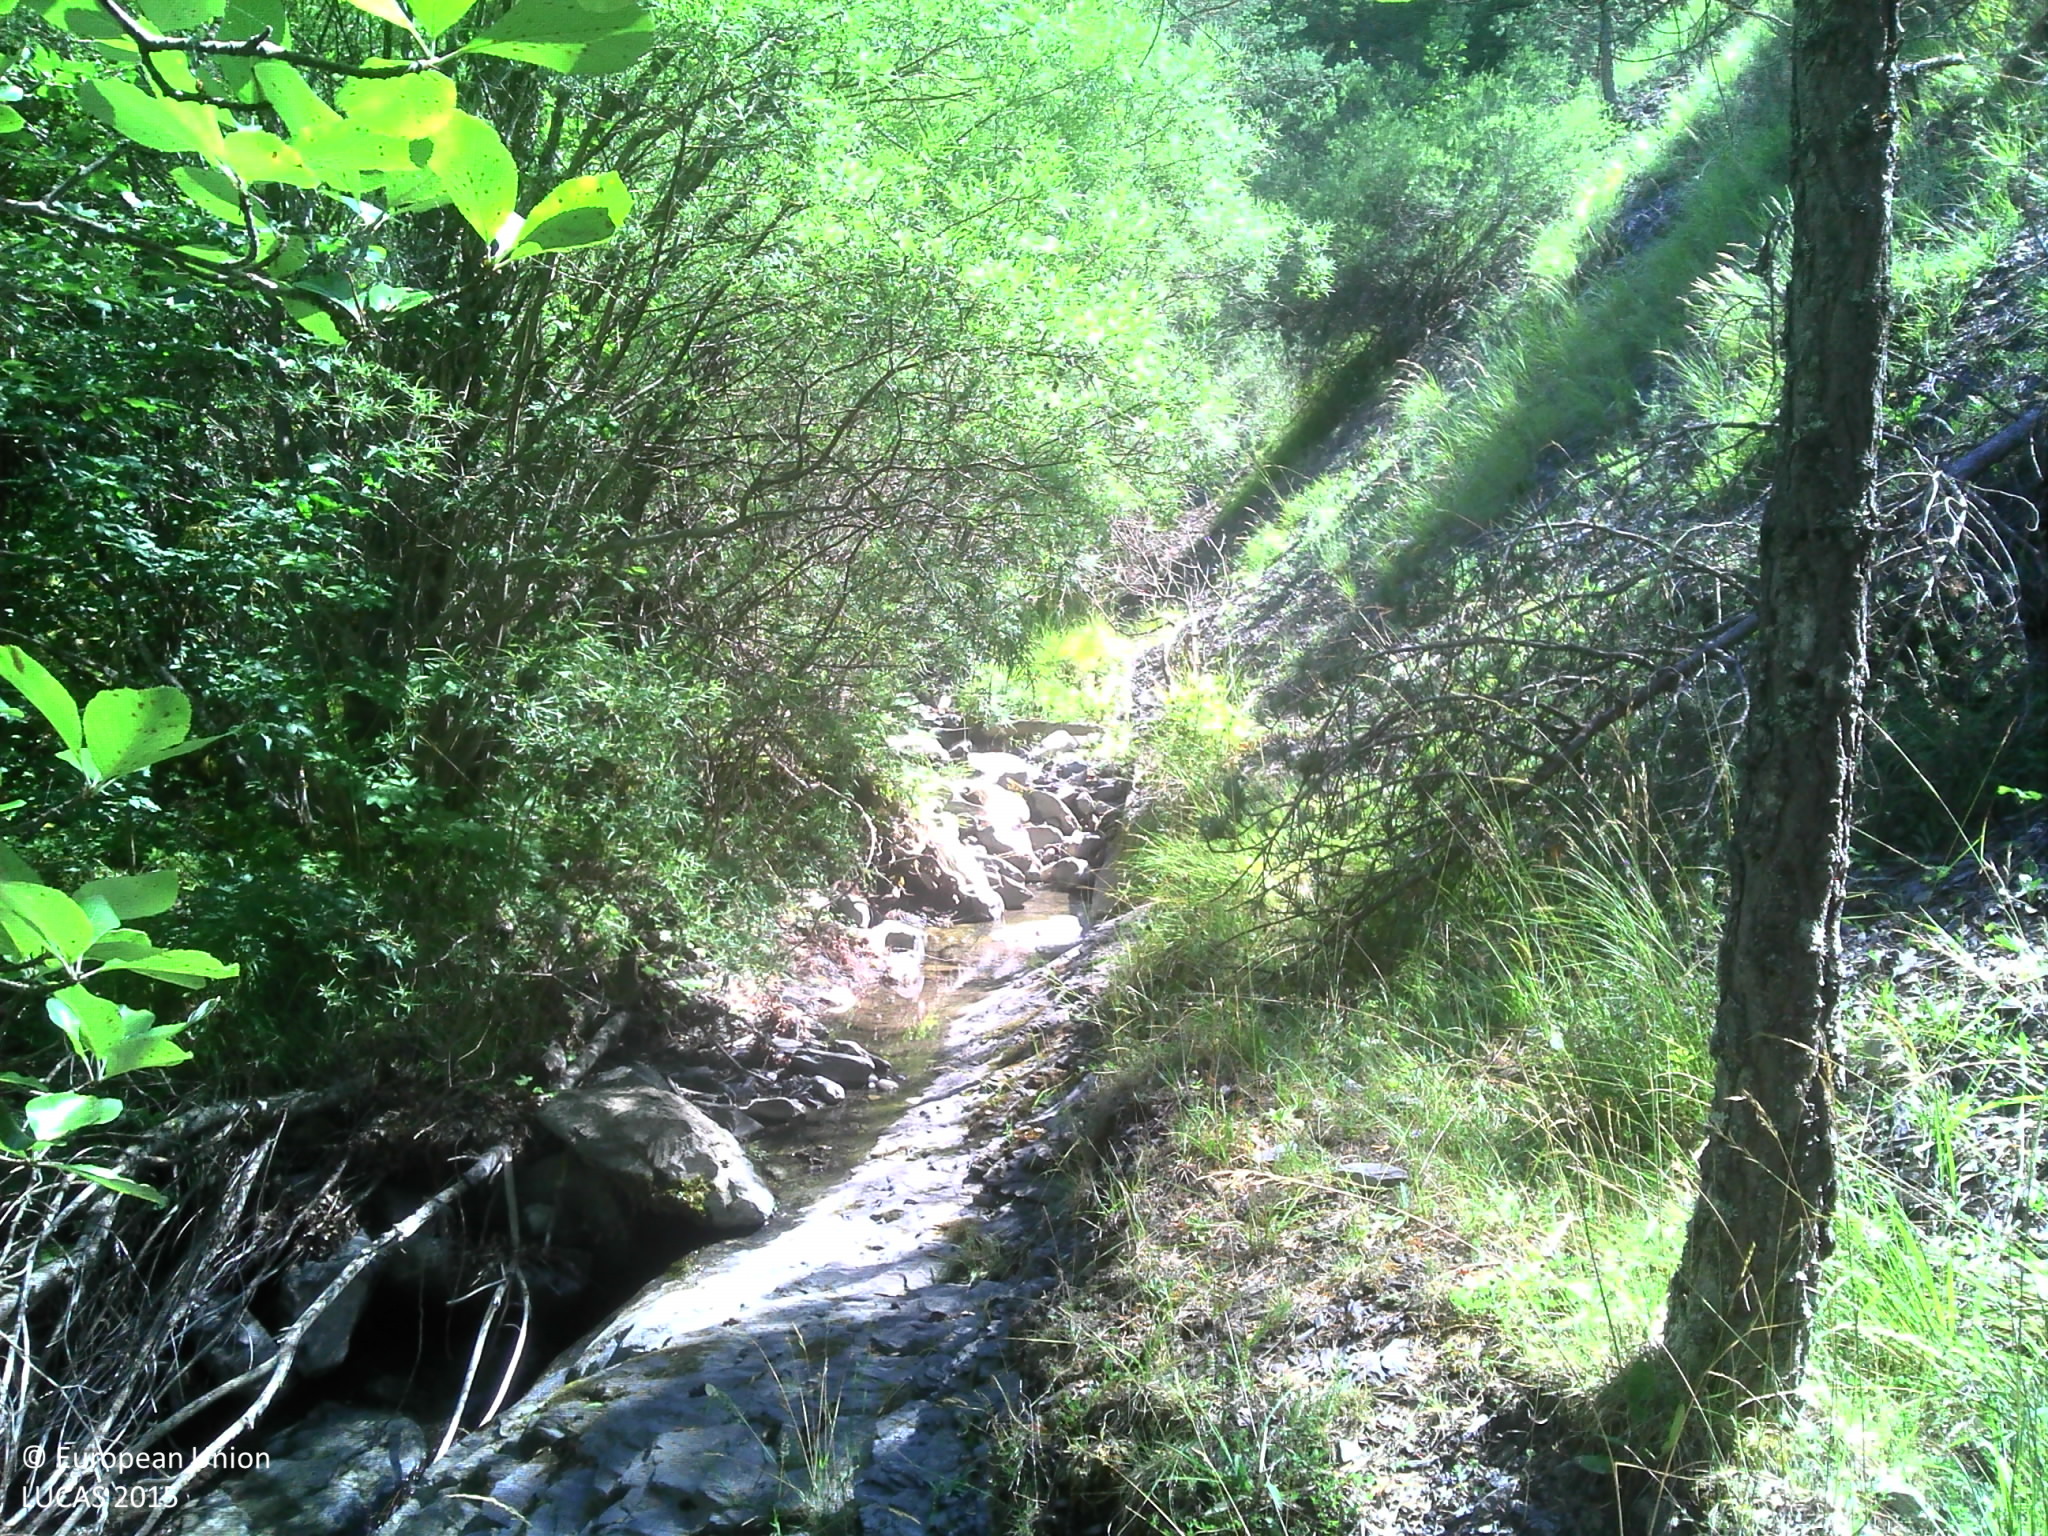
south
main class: Woodland
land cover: Pine dominated mixed woodland
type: alpine coniferous forest
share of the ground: 50 - 75 %
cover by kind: coniferous forest trees 30 %, broadleaved forest trees 20 %, shrubs 20 %, herbaceous plants 20 %, consolidated bare surface 10 %
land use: Forestry
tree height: > 5 m
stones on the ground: 10 - 25 %
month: August
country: FR
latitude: 44.3363
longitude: 6.2319
